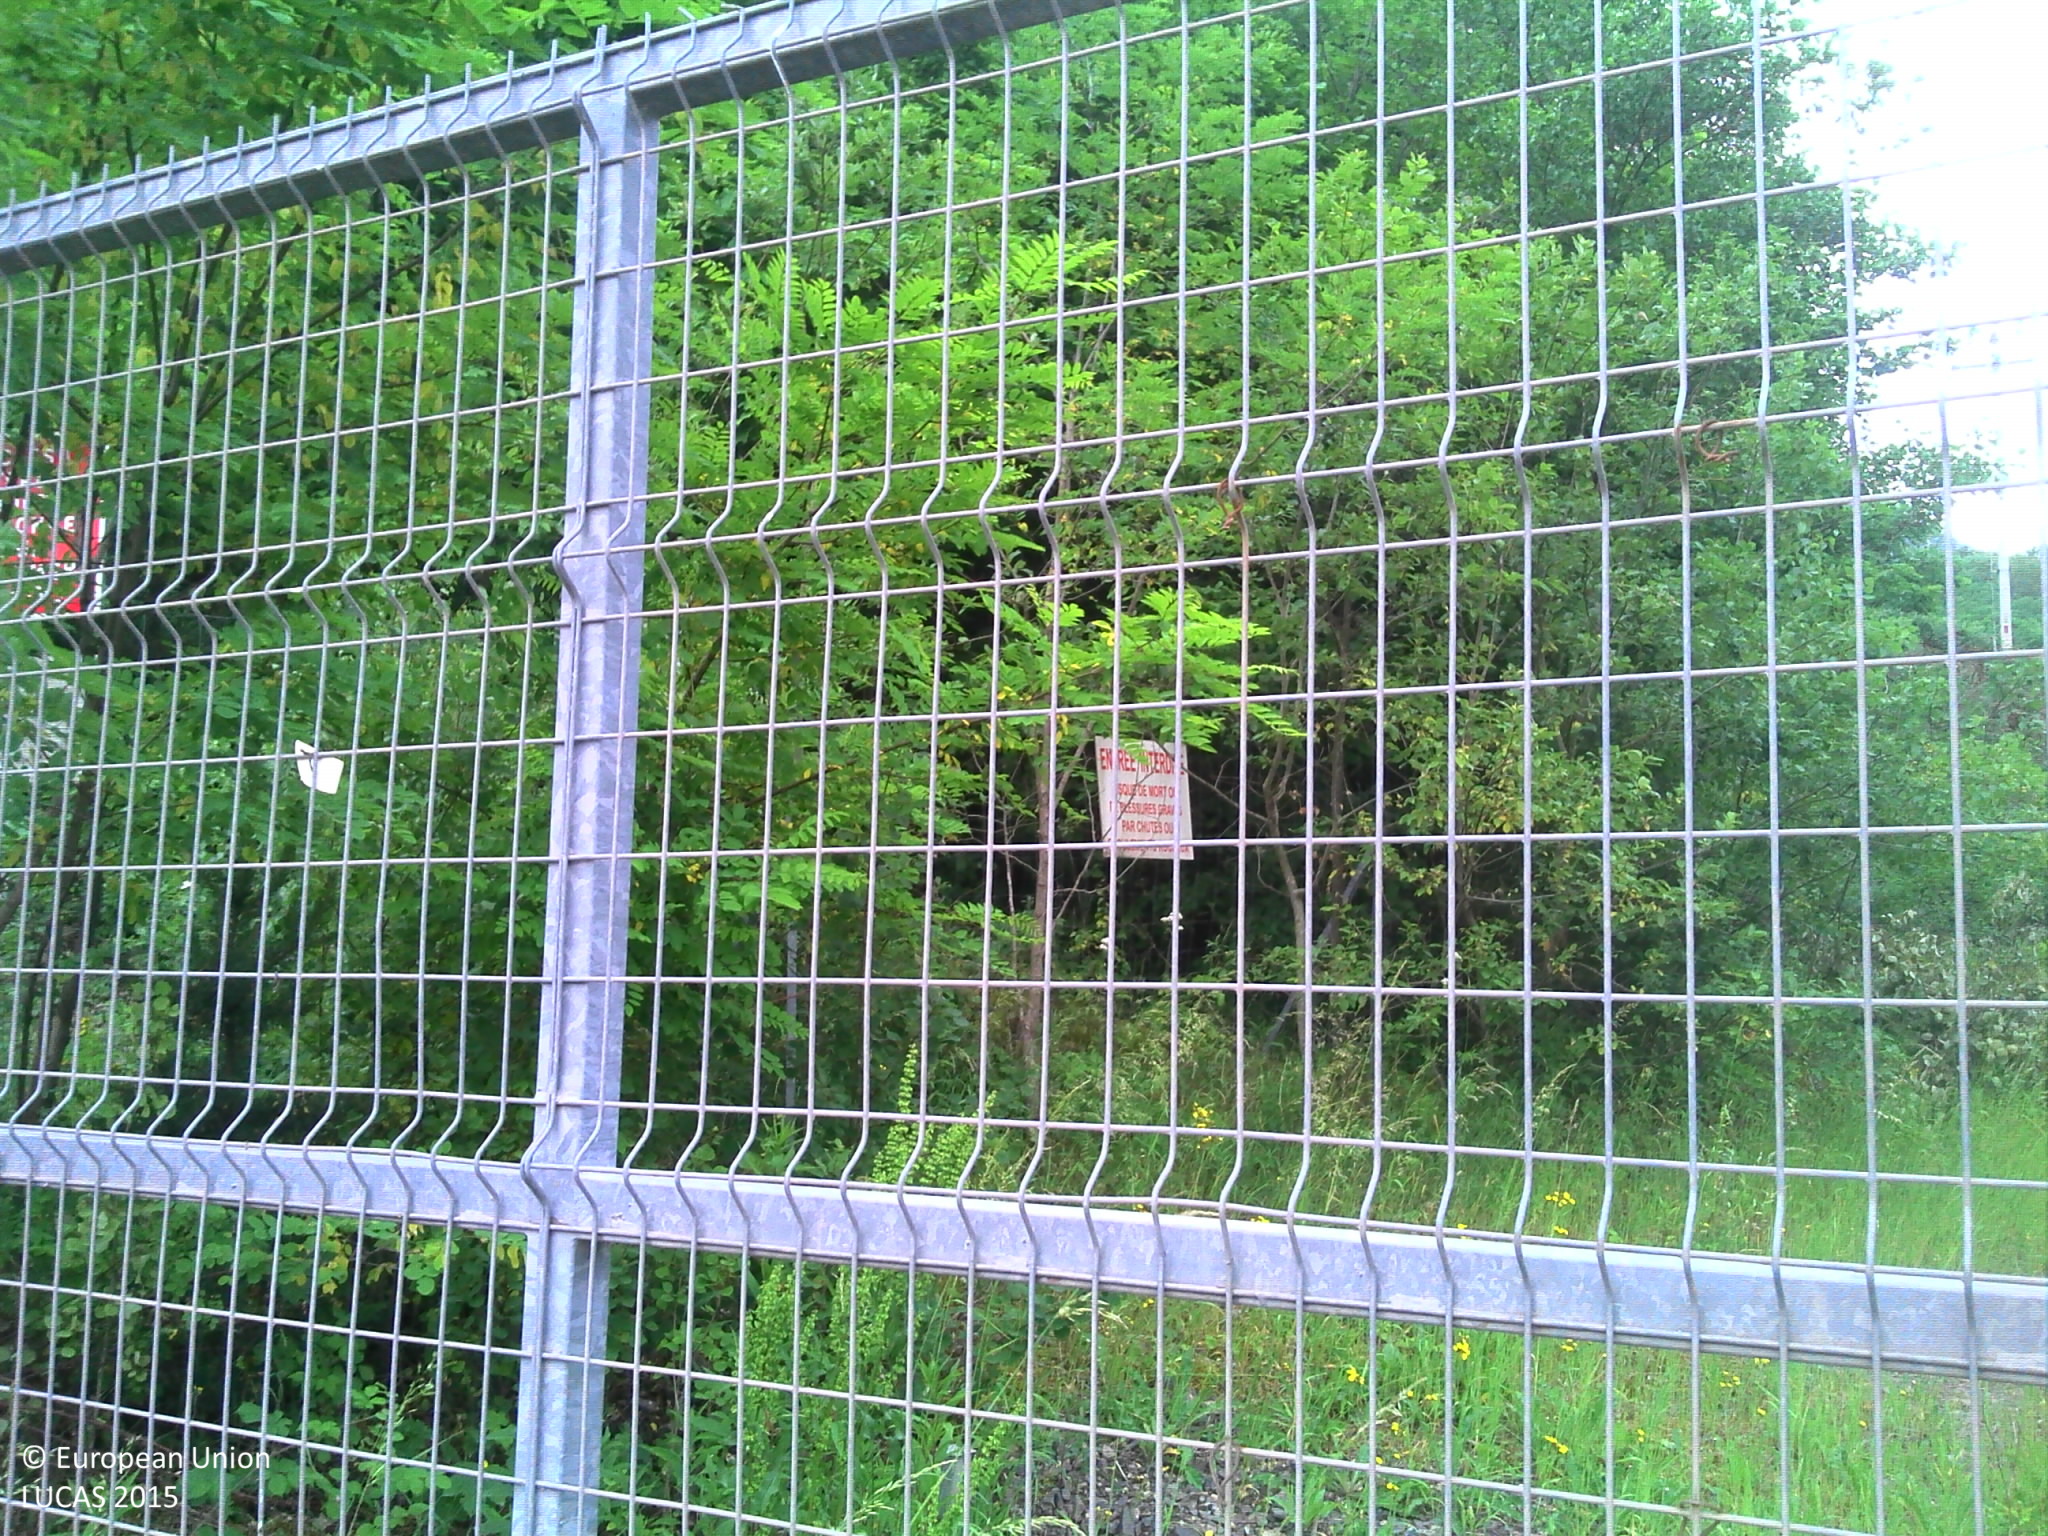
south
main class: Woodland
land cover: Broadleaved woodland
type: mesophytic deciduous forest
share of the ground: > 75 %
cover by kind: broadleaved forest trees 95 %, herbaceous plants 5 %
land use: Forestry
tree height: > 5 m
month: June
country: FR
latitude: 48.4454
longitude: 7.4187
